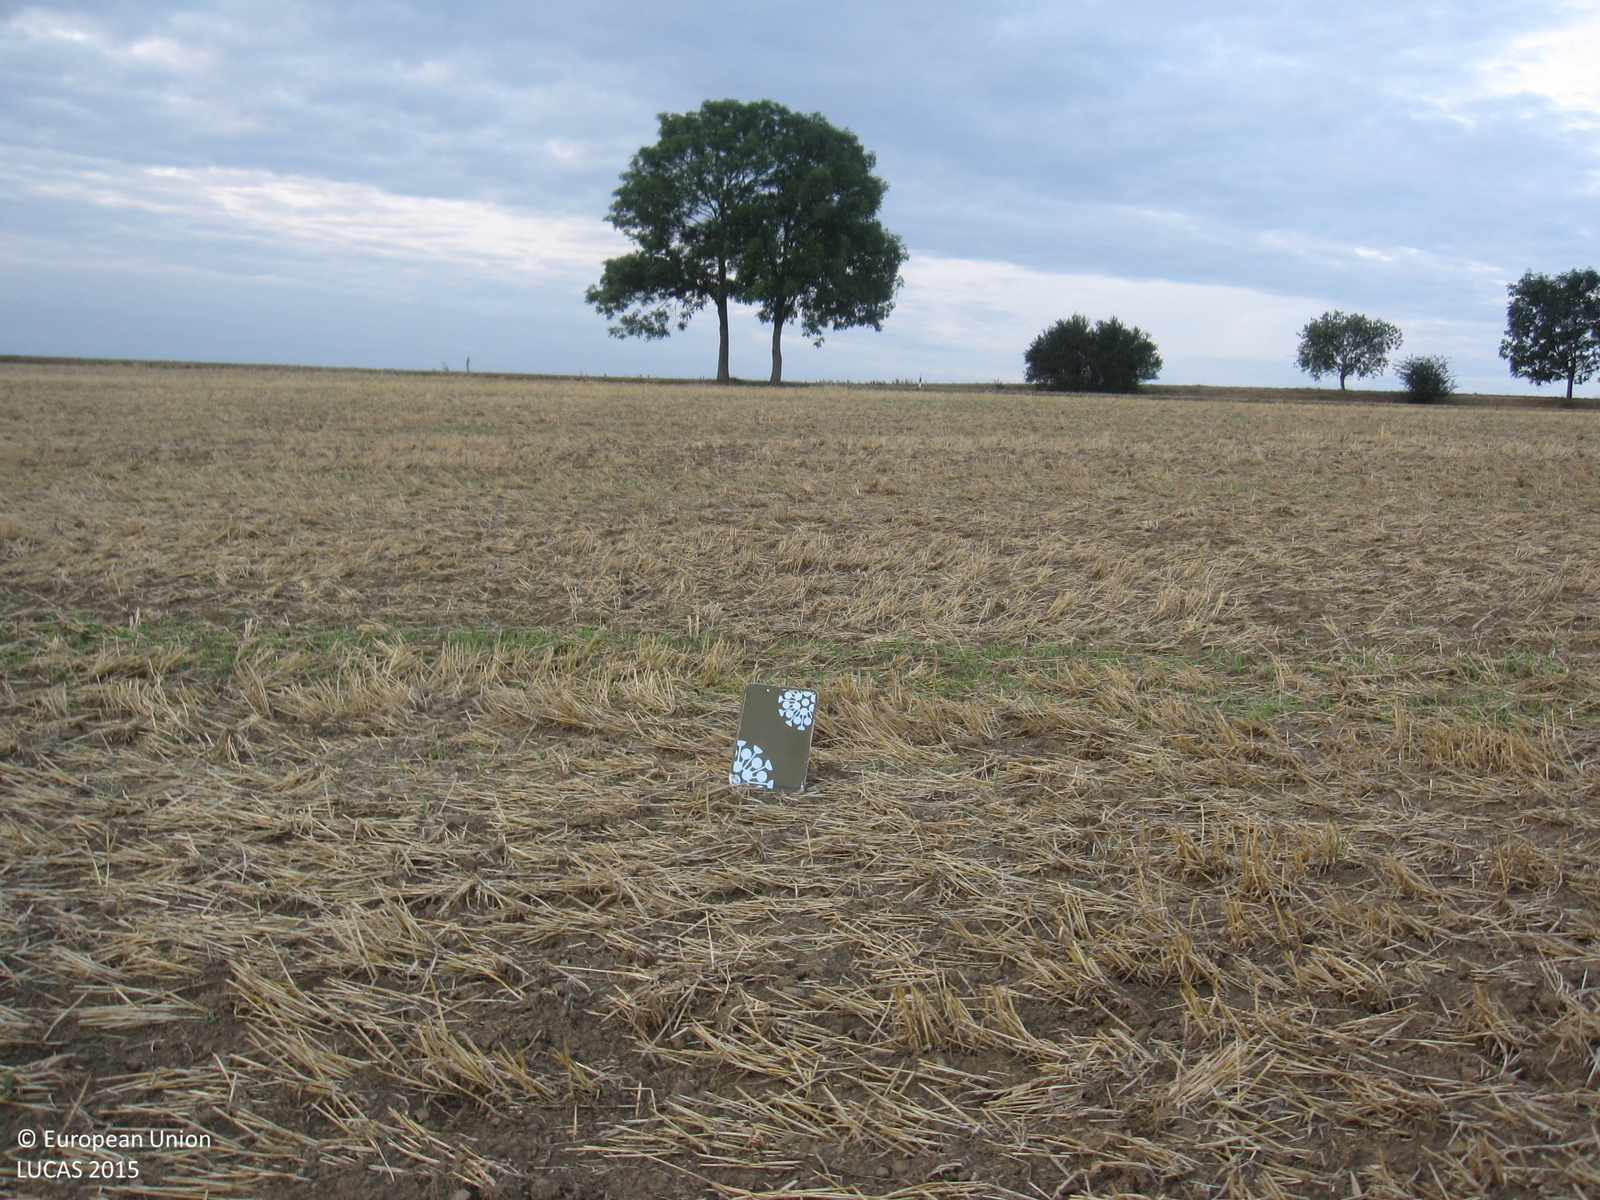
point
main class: Cropland
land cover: Durum wheat
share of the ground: 25 - 50 %
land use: Agriculture (excluding fallow land and kitchen gardens)
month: August
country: DE
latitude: 50.4717
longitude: 12.0427
